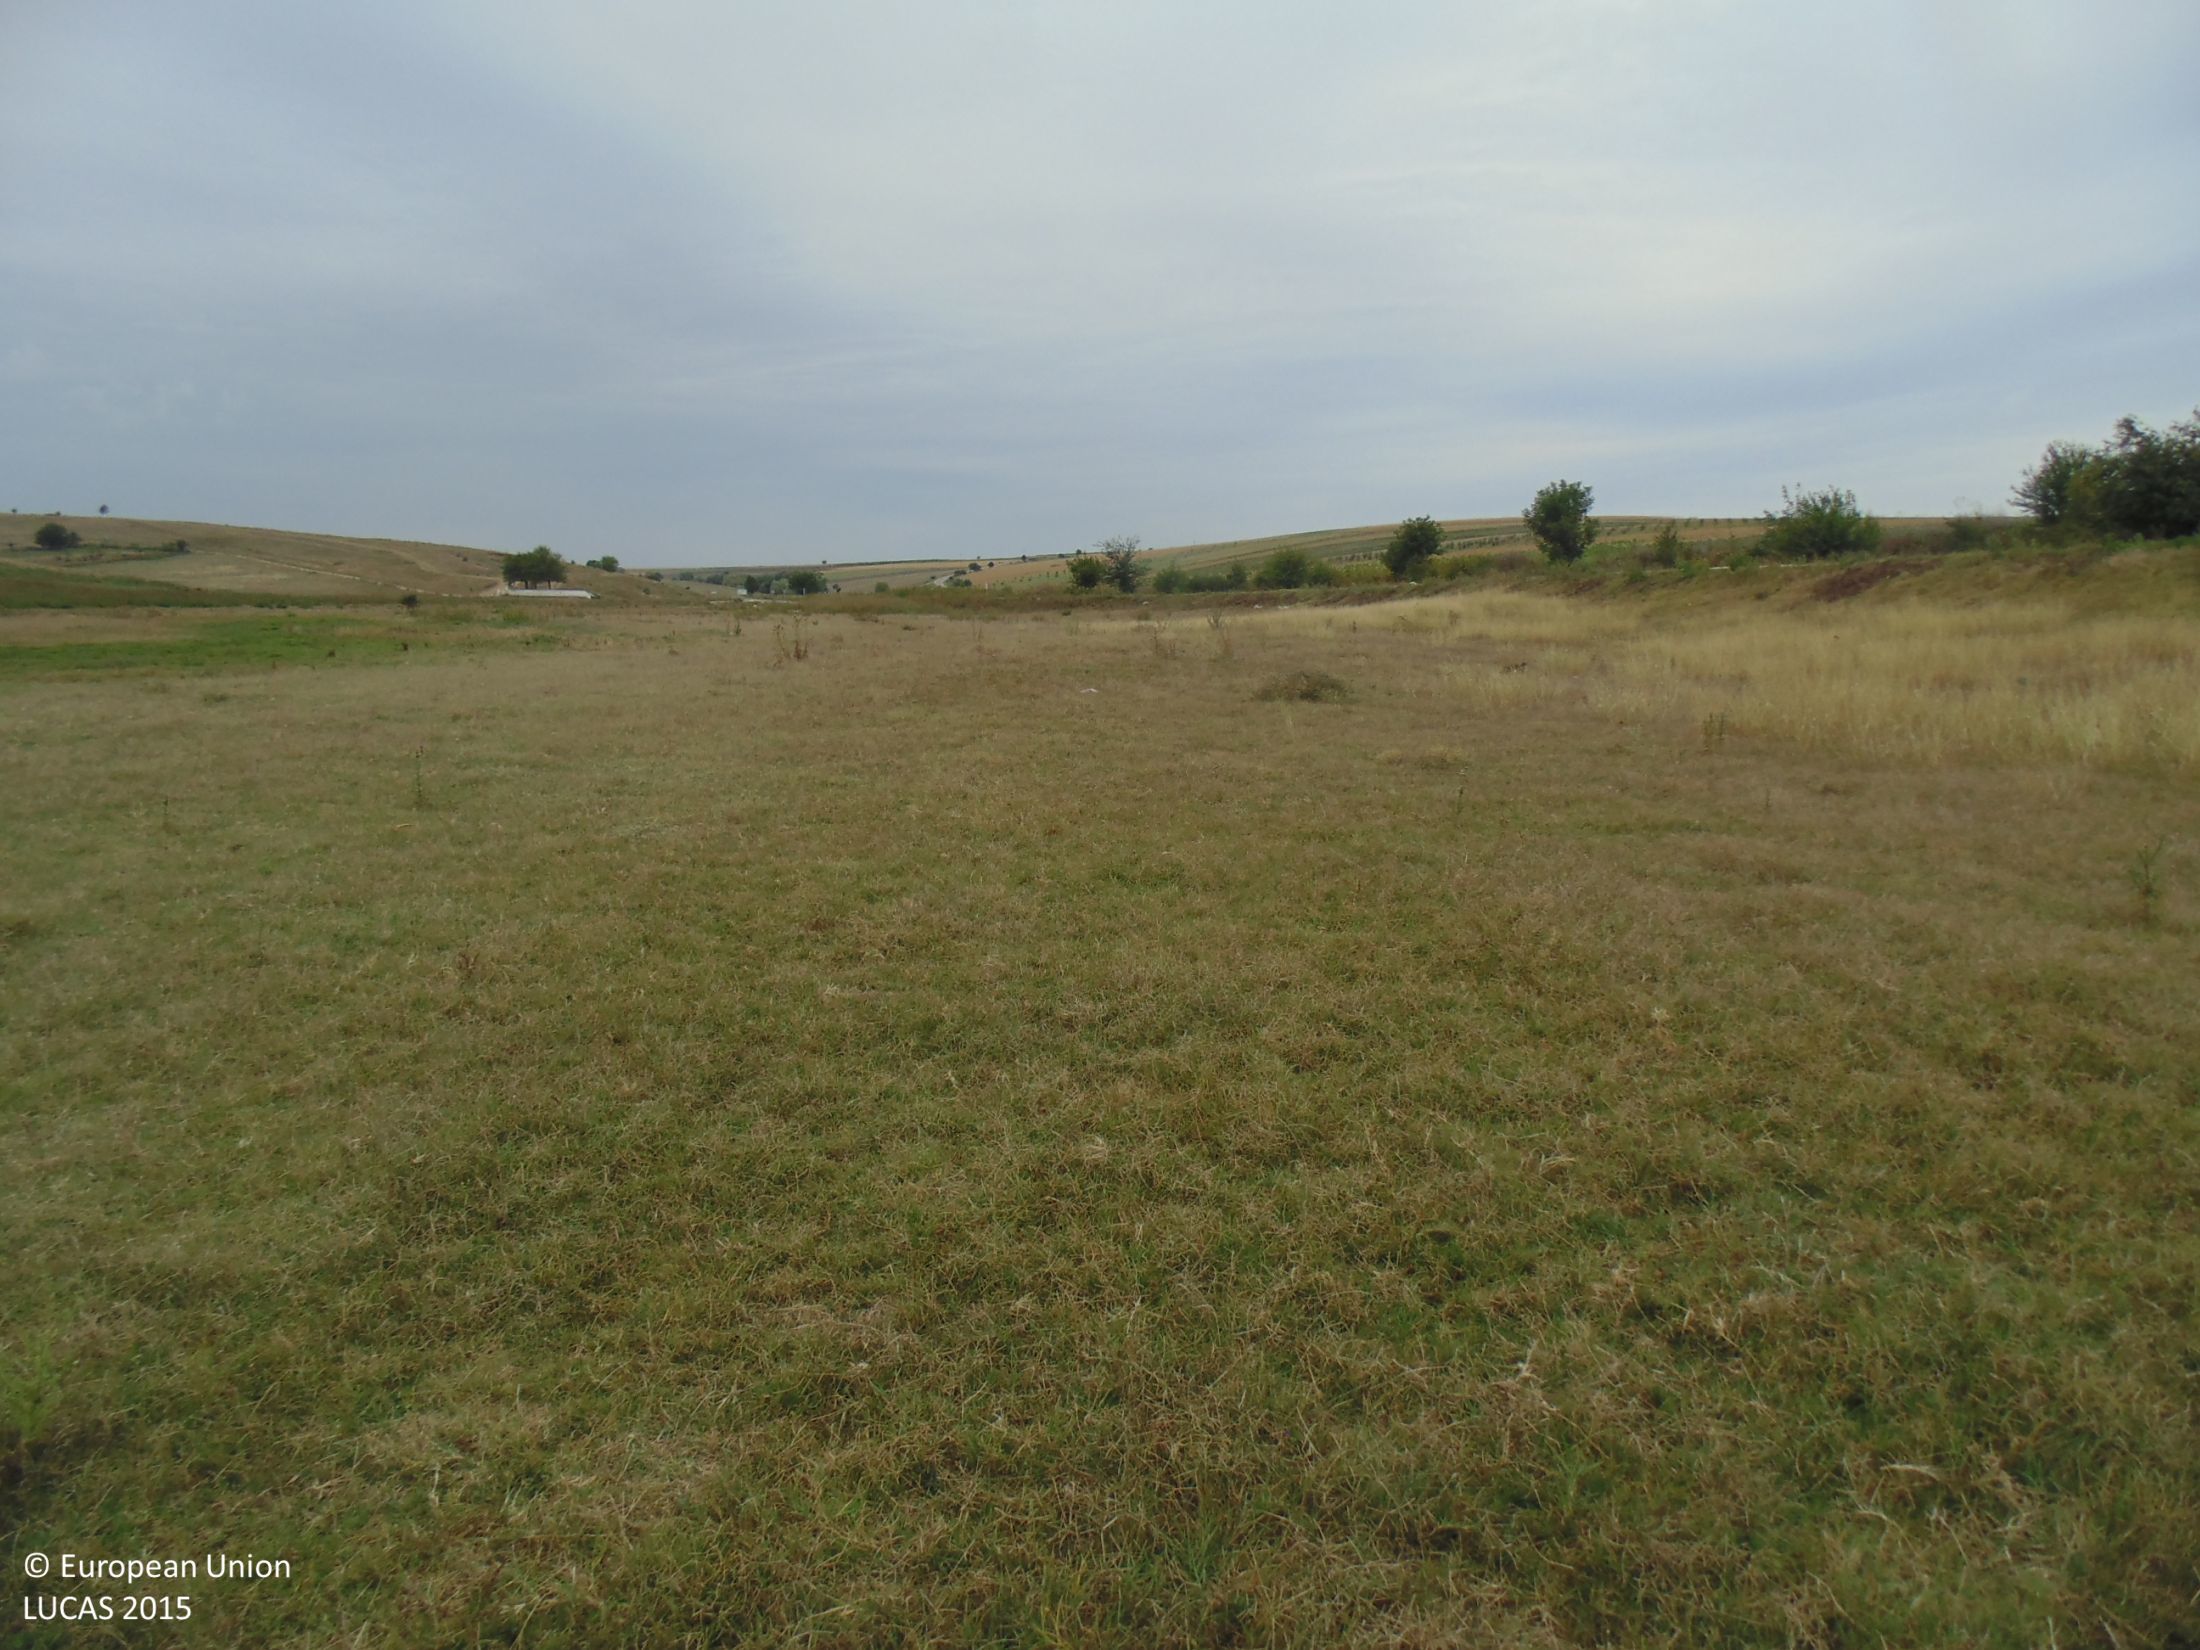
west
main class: Grassland
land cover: Grassland without tree/shrub cover
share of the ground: > 75 %
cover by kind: herbaceous plants 100 %
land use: Agriculture (excluding fallow land and kitchen gardens)
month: September
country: BG
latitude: 43.9586
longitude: 26.9325
